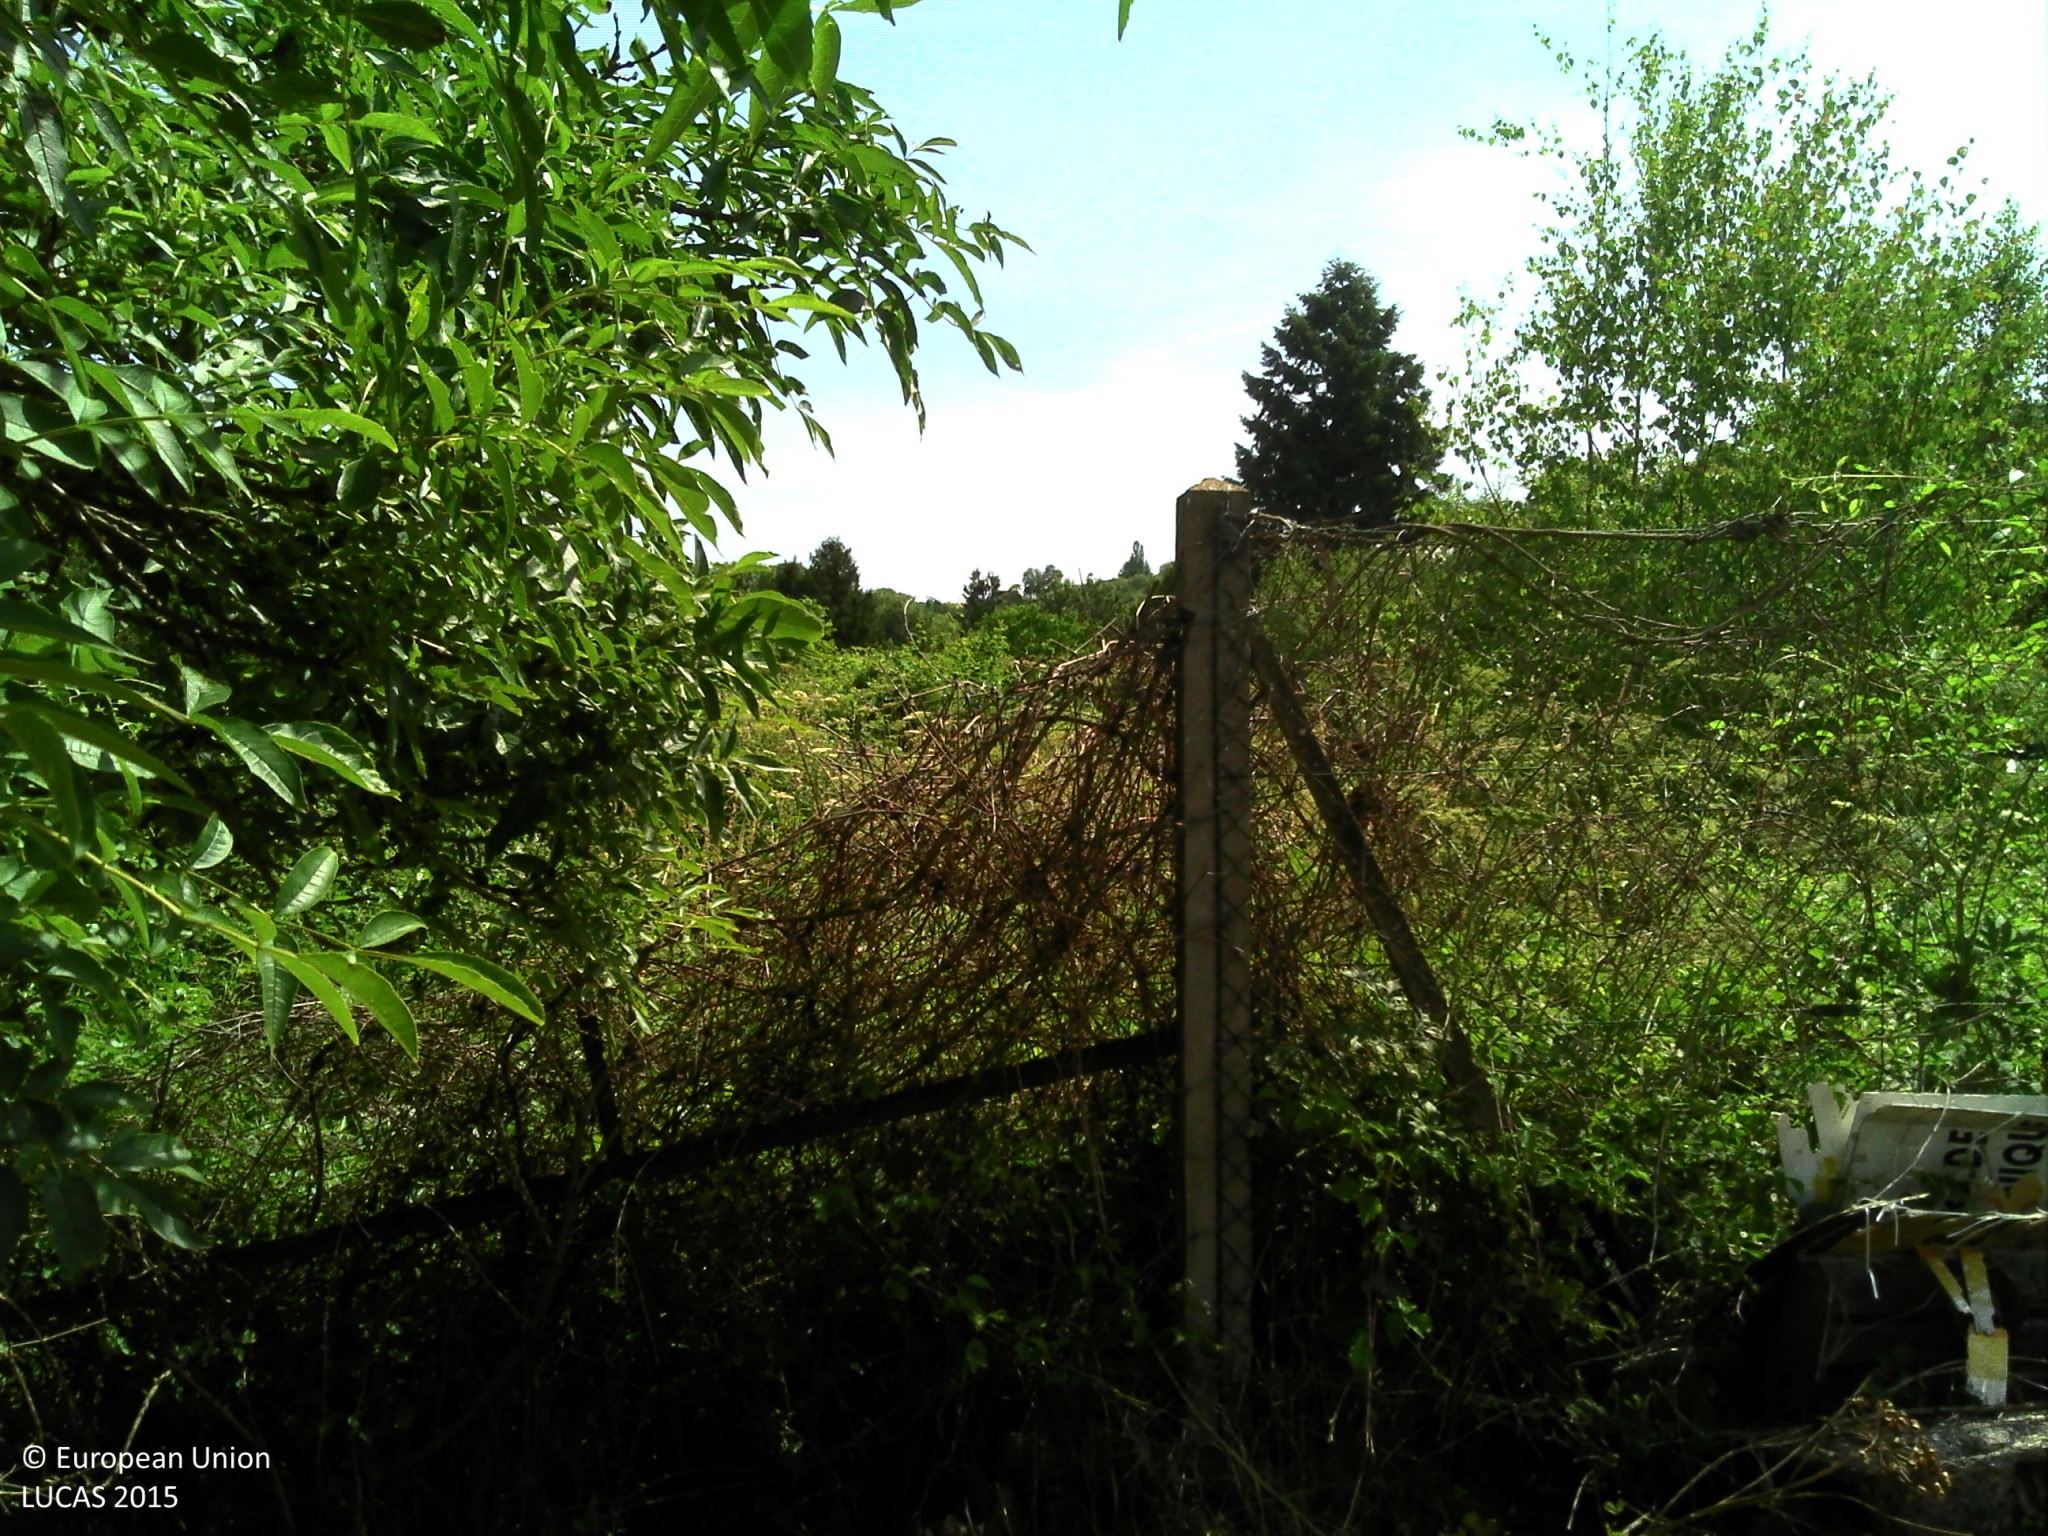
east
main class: Grassland
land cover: Grassland without tree/shrub cover
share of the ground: > 75 %
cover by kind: herbaceous plants 100 %
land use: Community services
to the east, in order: Grassland without tree/shrub cover; Artificial constructions in urban areas
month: June
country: FR
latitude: 47.4545
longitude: 3.5104
